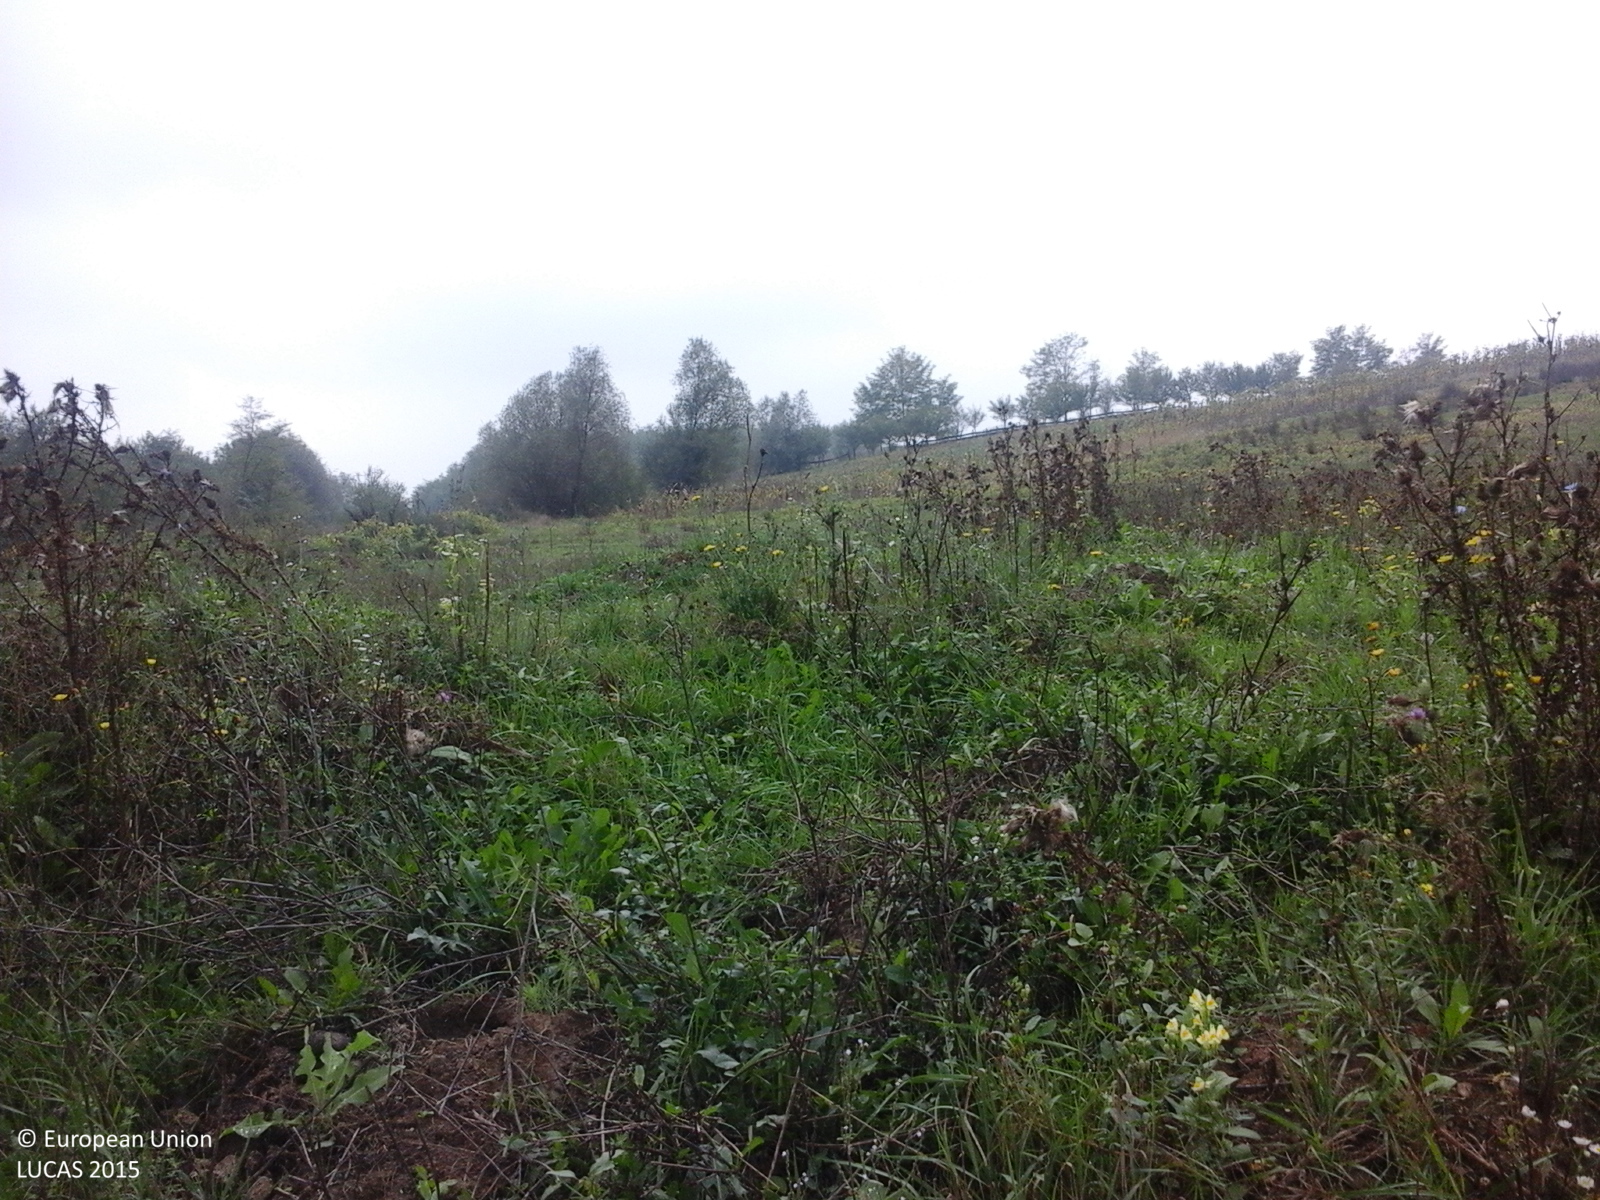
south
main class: Grassland
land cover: Spontaneously vegetated surfaces
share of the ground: > 75 %
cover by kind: herbaceous plants 100 %
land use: Fallow land
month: September
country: RO
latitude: 44.8531
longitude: 22.9156
